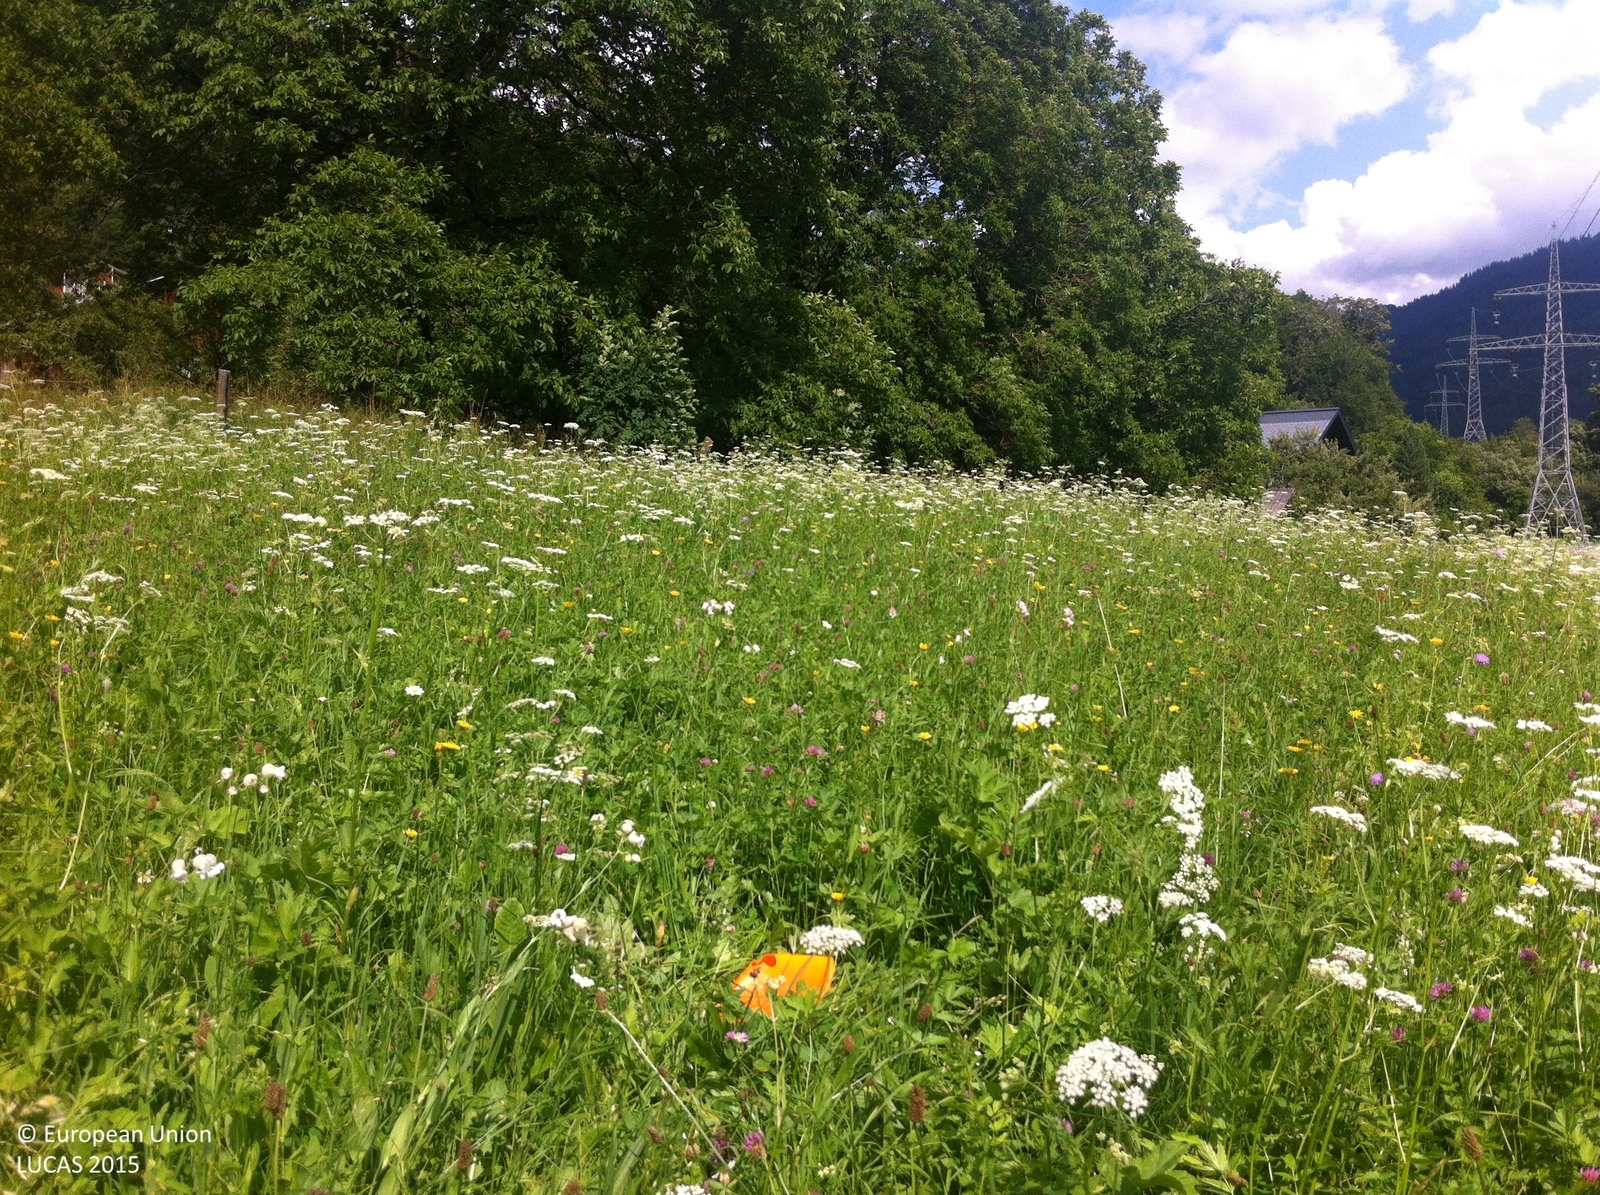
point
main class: Grassland
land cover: Grassland without tree/shrub cover
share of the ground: > 75 %
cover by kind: herbaceous plants 100 %
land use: Agriculture (excluding fallow land and kitchen gardens)
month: July
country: AT
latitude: 47.1255
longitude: 9.9868
